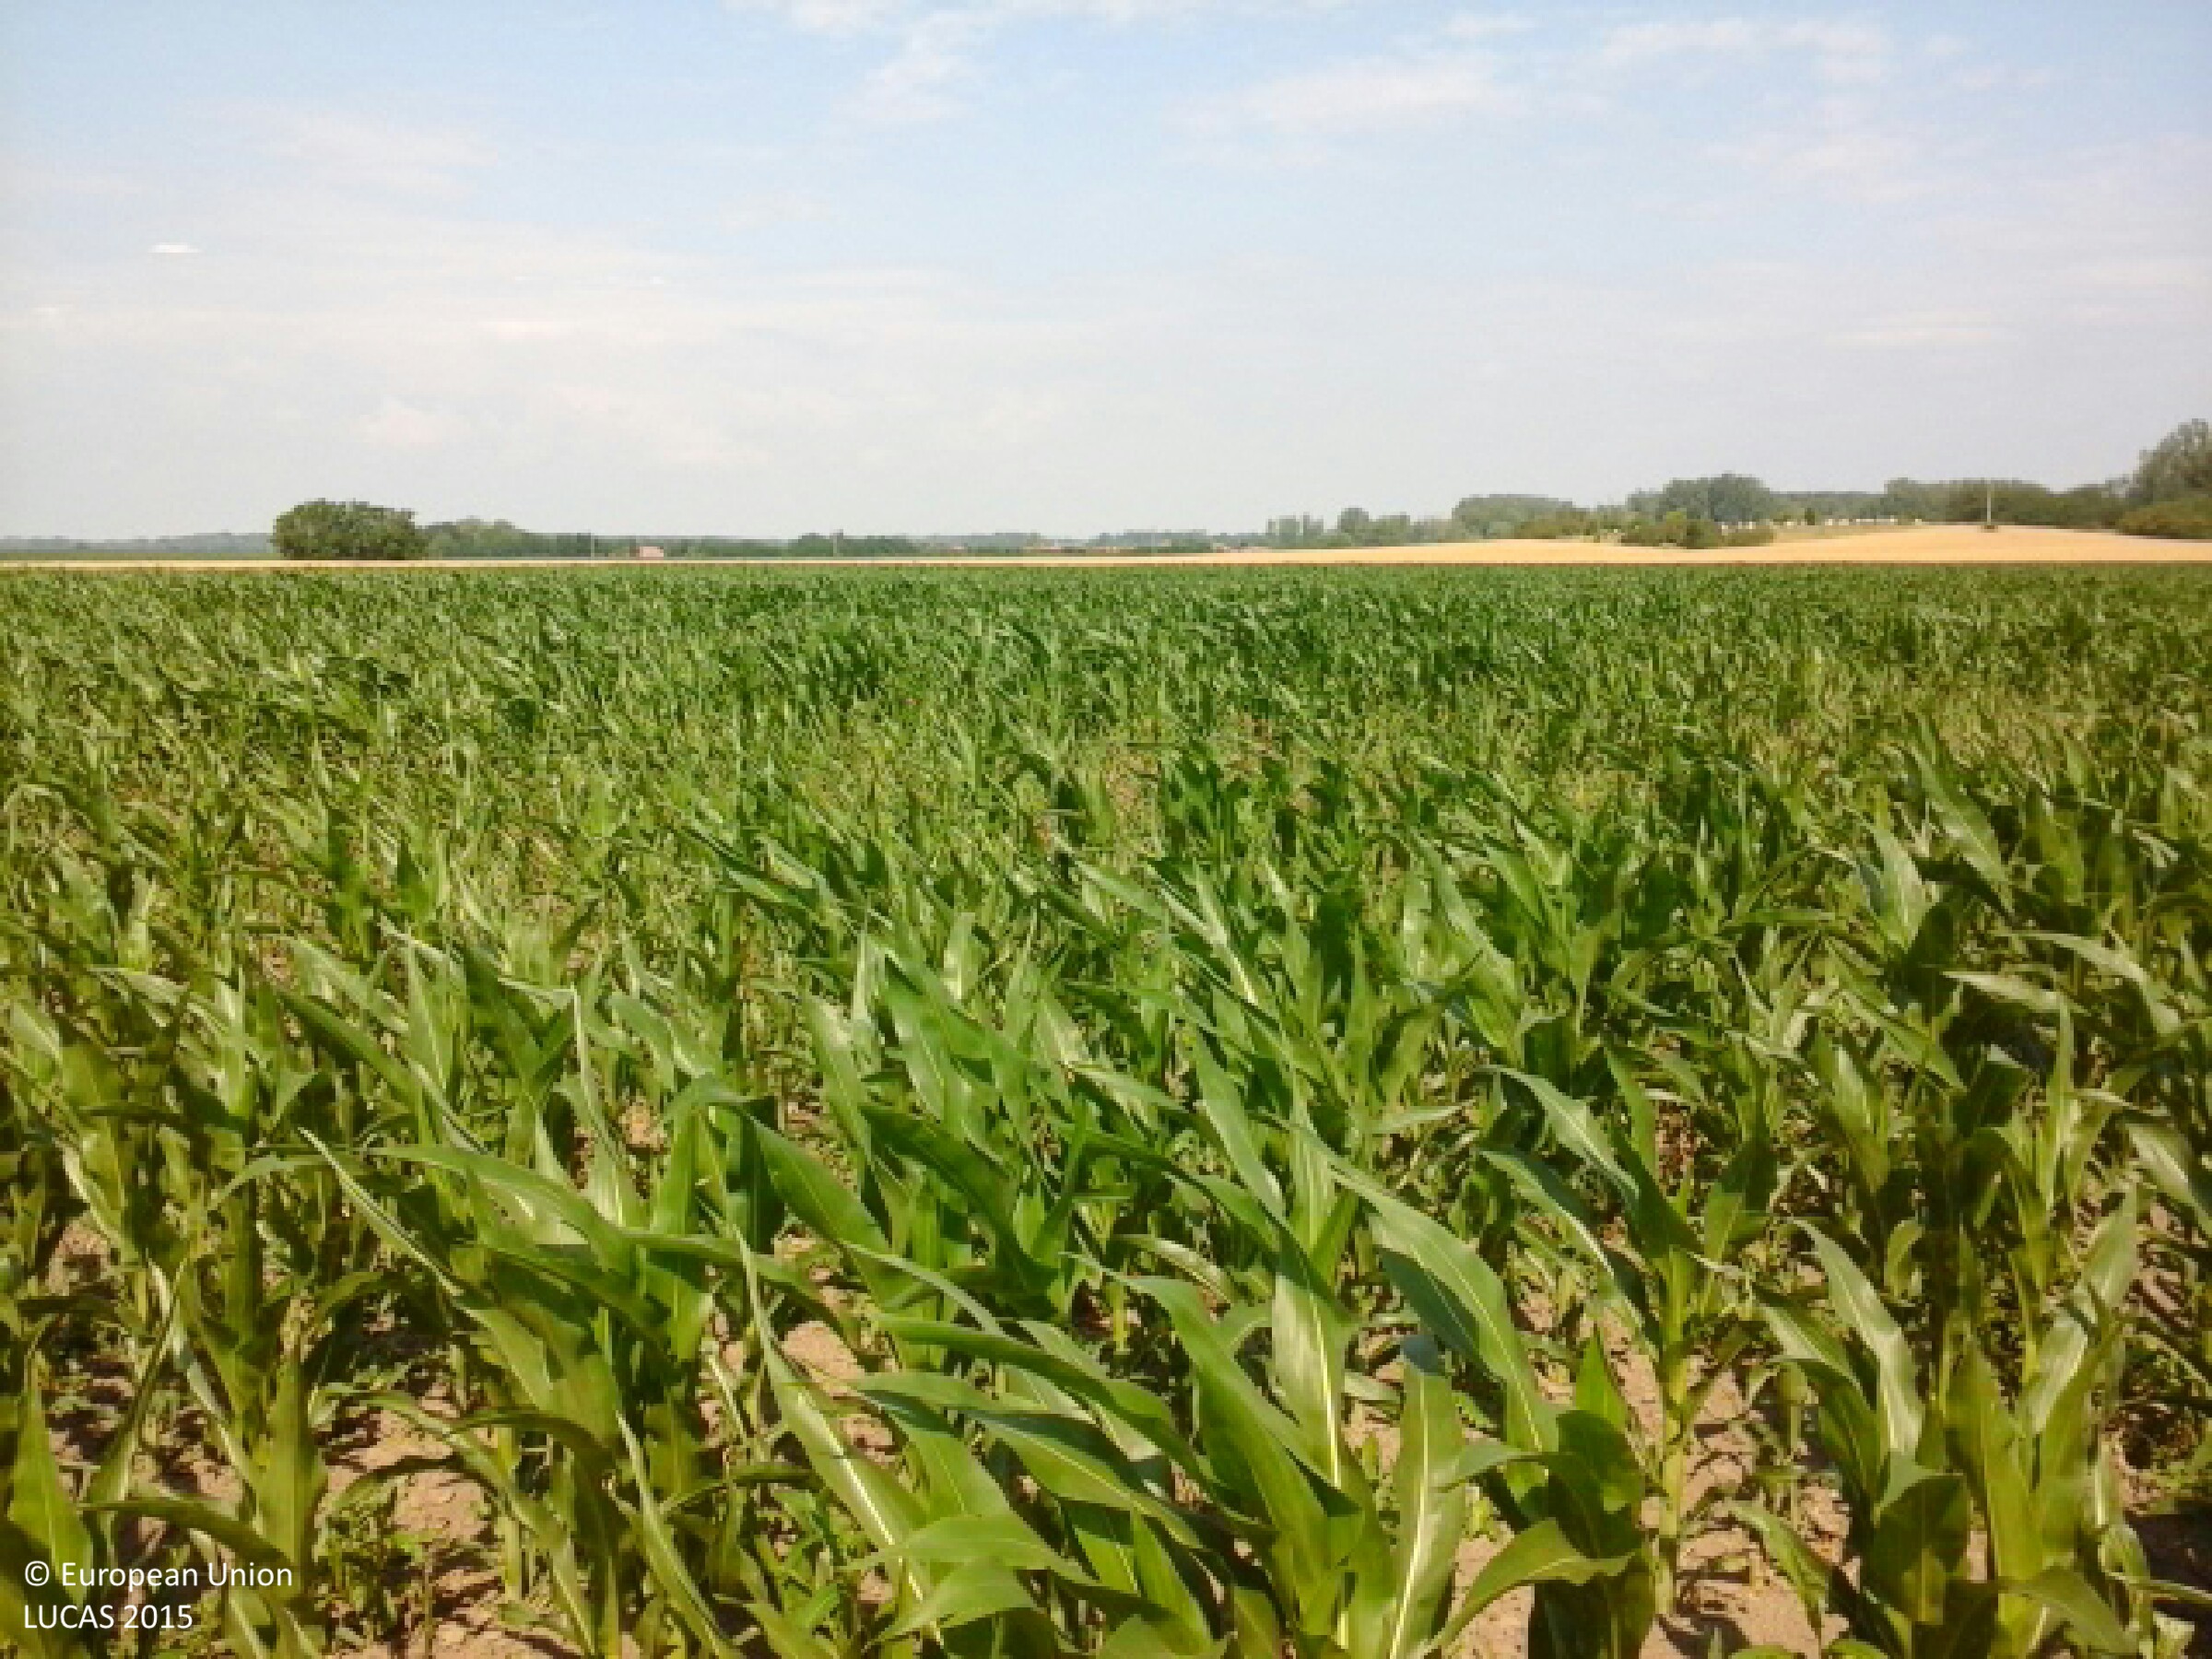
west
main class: Cropland
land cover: Maize
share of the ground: 50 - 75 %
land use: Agriculture (excluding fallow land and kitchen gardens)
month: June
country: HU
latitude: 48.2178
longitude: 21.8546
